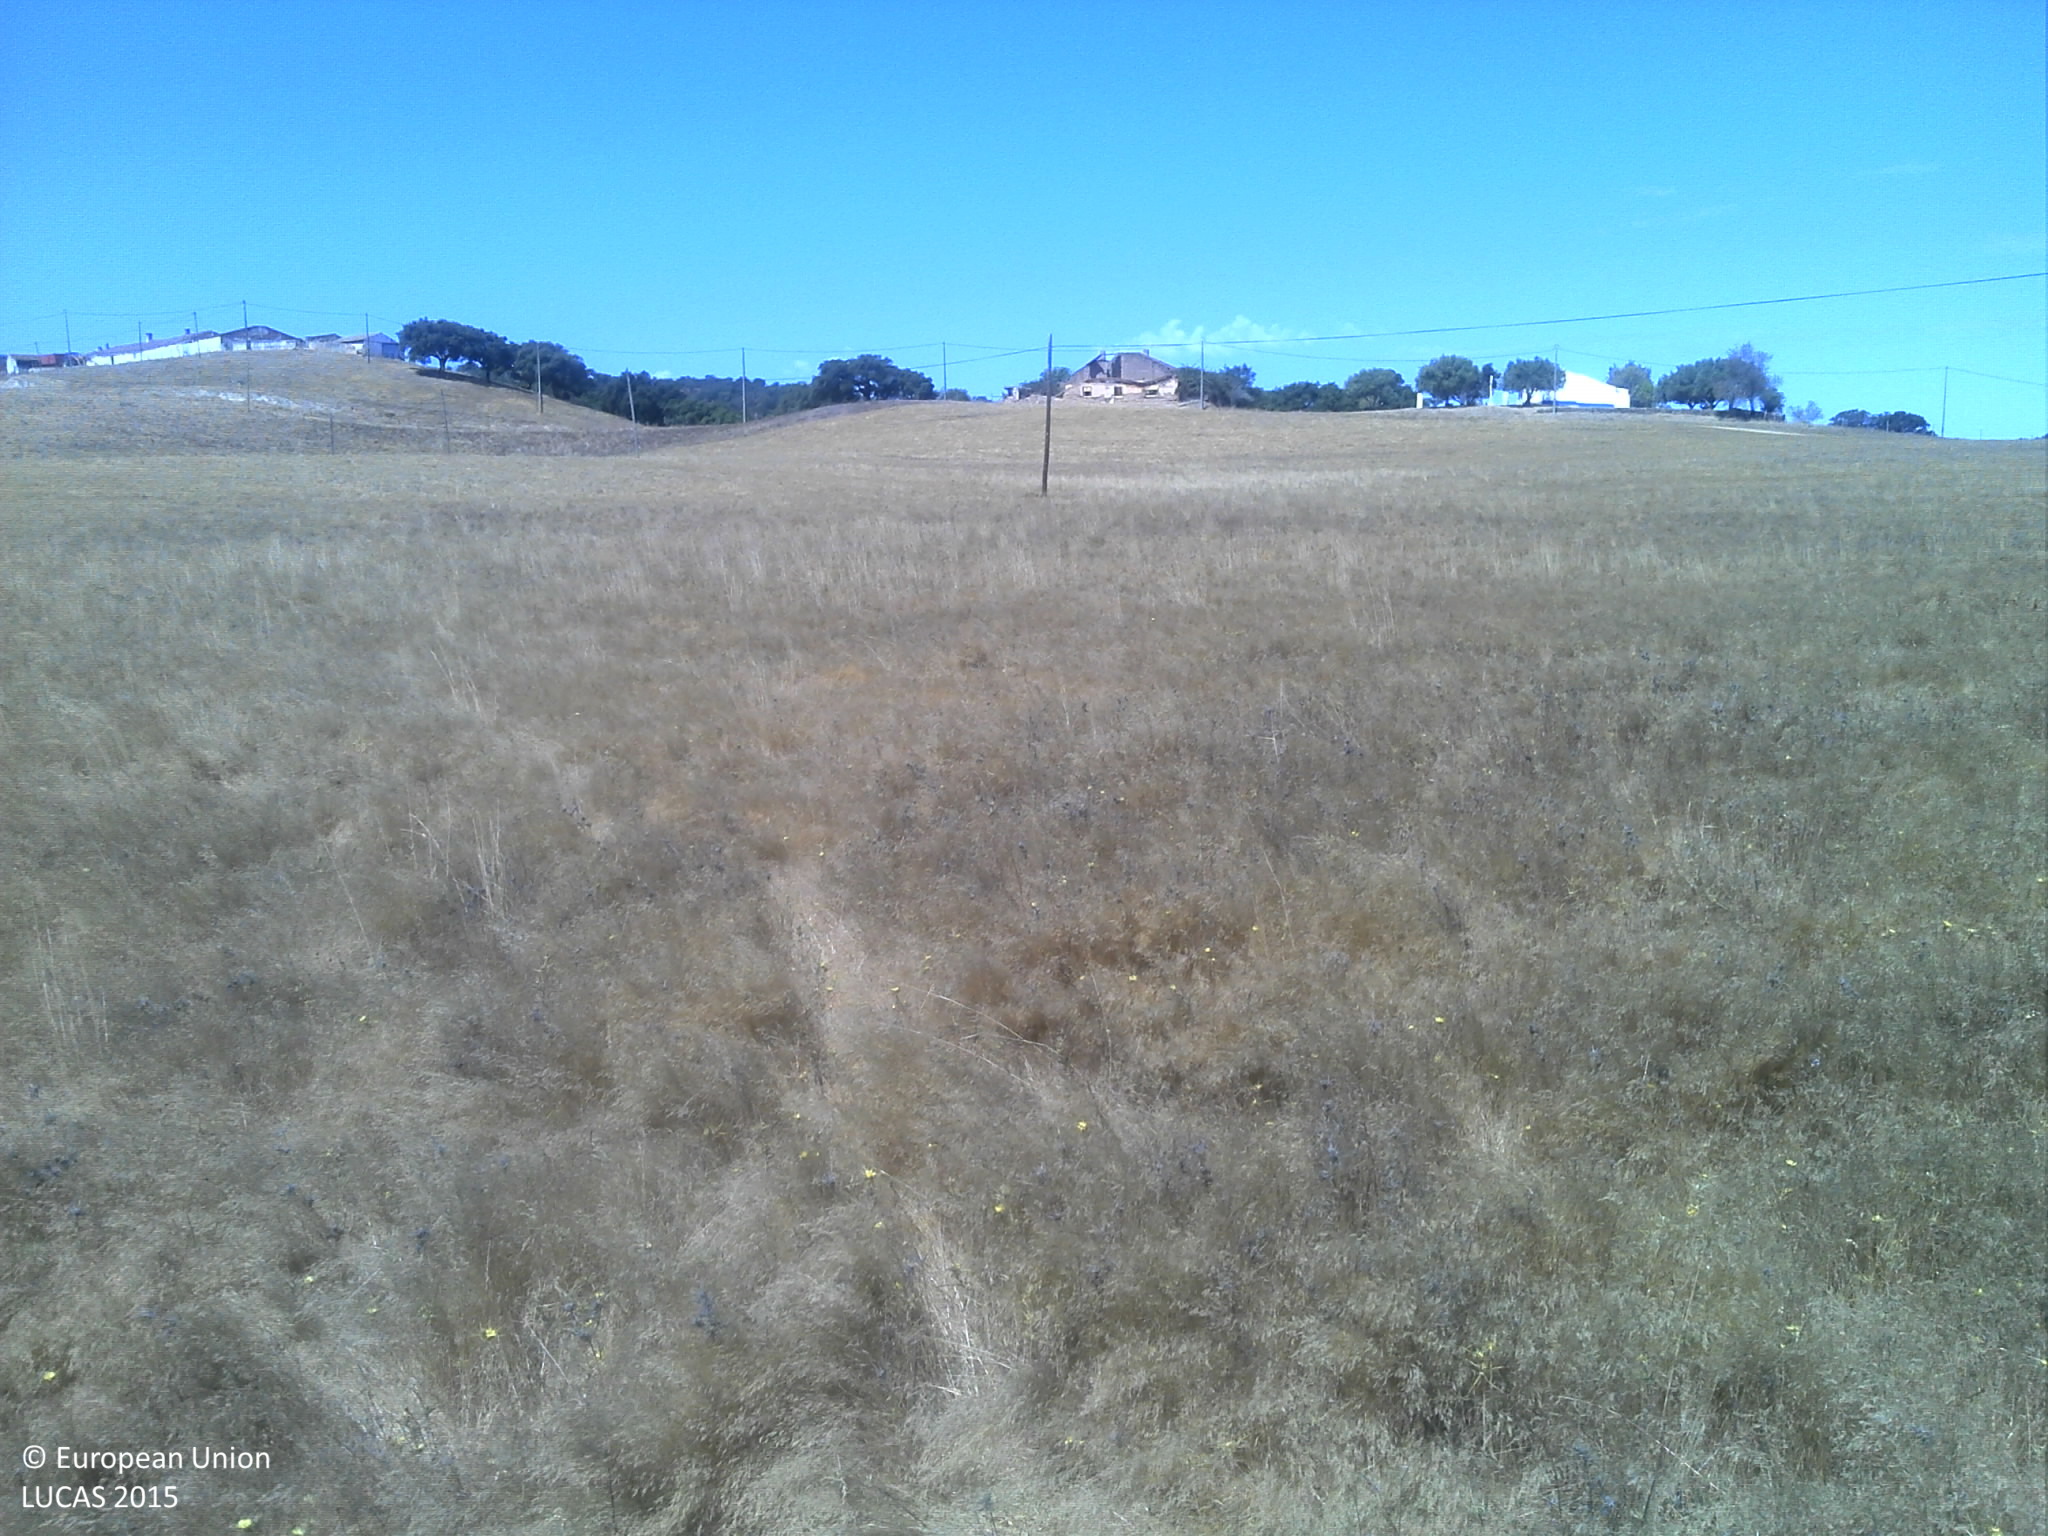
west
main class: Grassland
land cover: Grassland without tree/shrub cover
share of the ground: > 75 %
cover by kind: herbaceous plants 75 %, consolidated bare surface 25 %
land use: Agriculture (excluding fallow land and kitchen gardens)
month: August
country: PT
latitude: 37.7493
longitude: -8.5033
